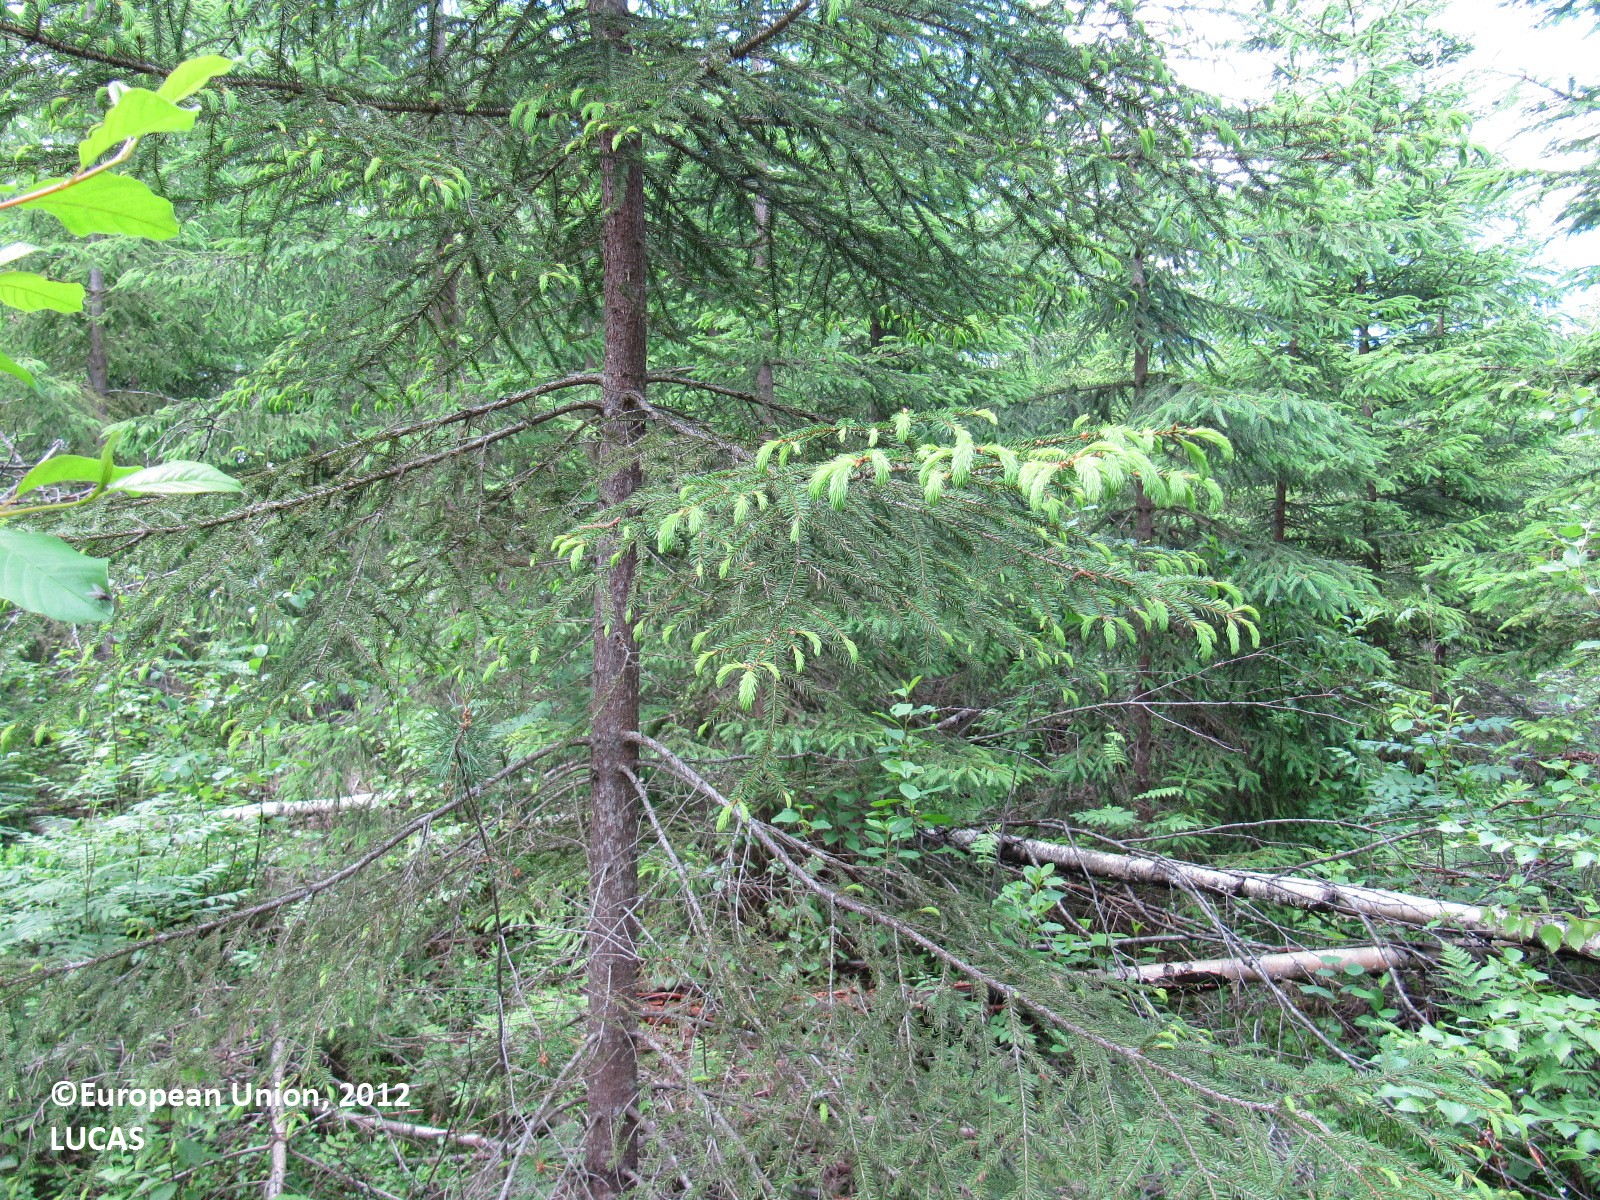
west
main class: Woodland
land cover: Spruce dominated mixed woodland
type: boreal forest
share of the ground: > 75 %
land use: Forestry
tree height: > 5 m
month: June
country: FI
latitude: 60.7690
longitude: 24.1031
